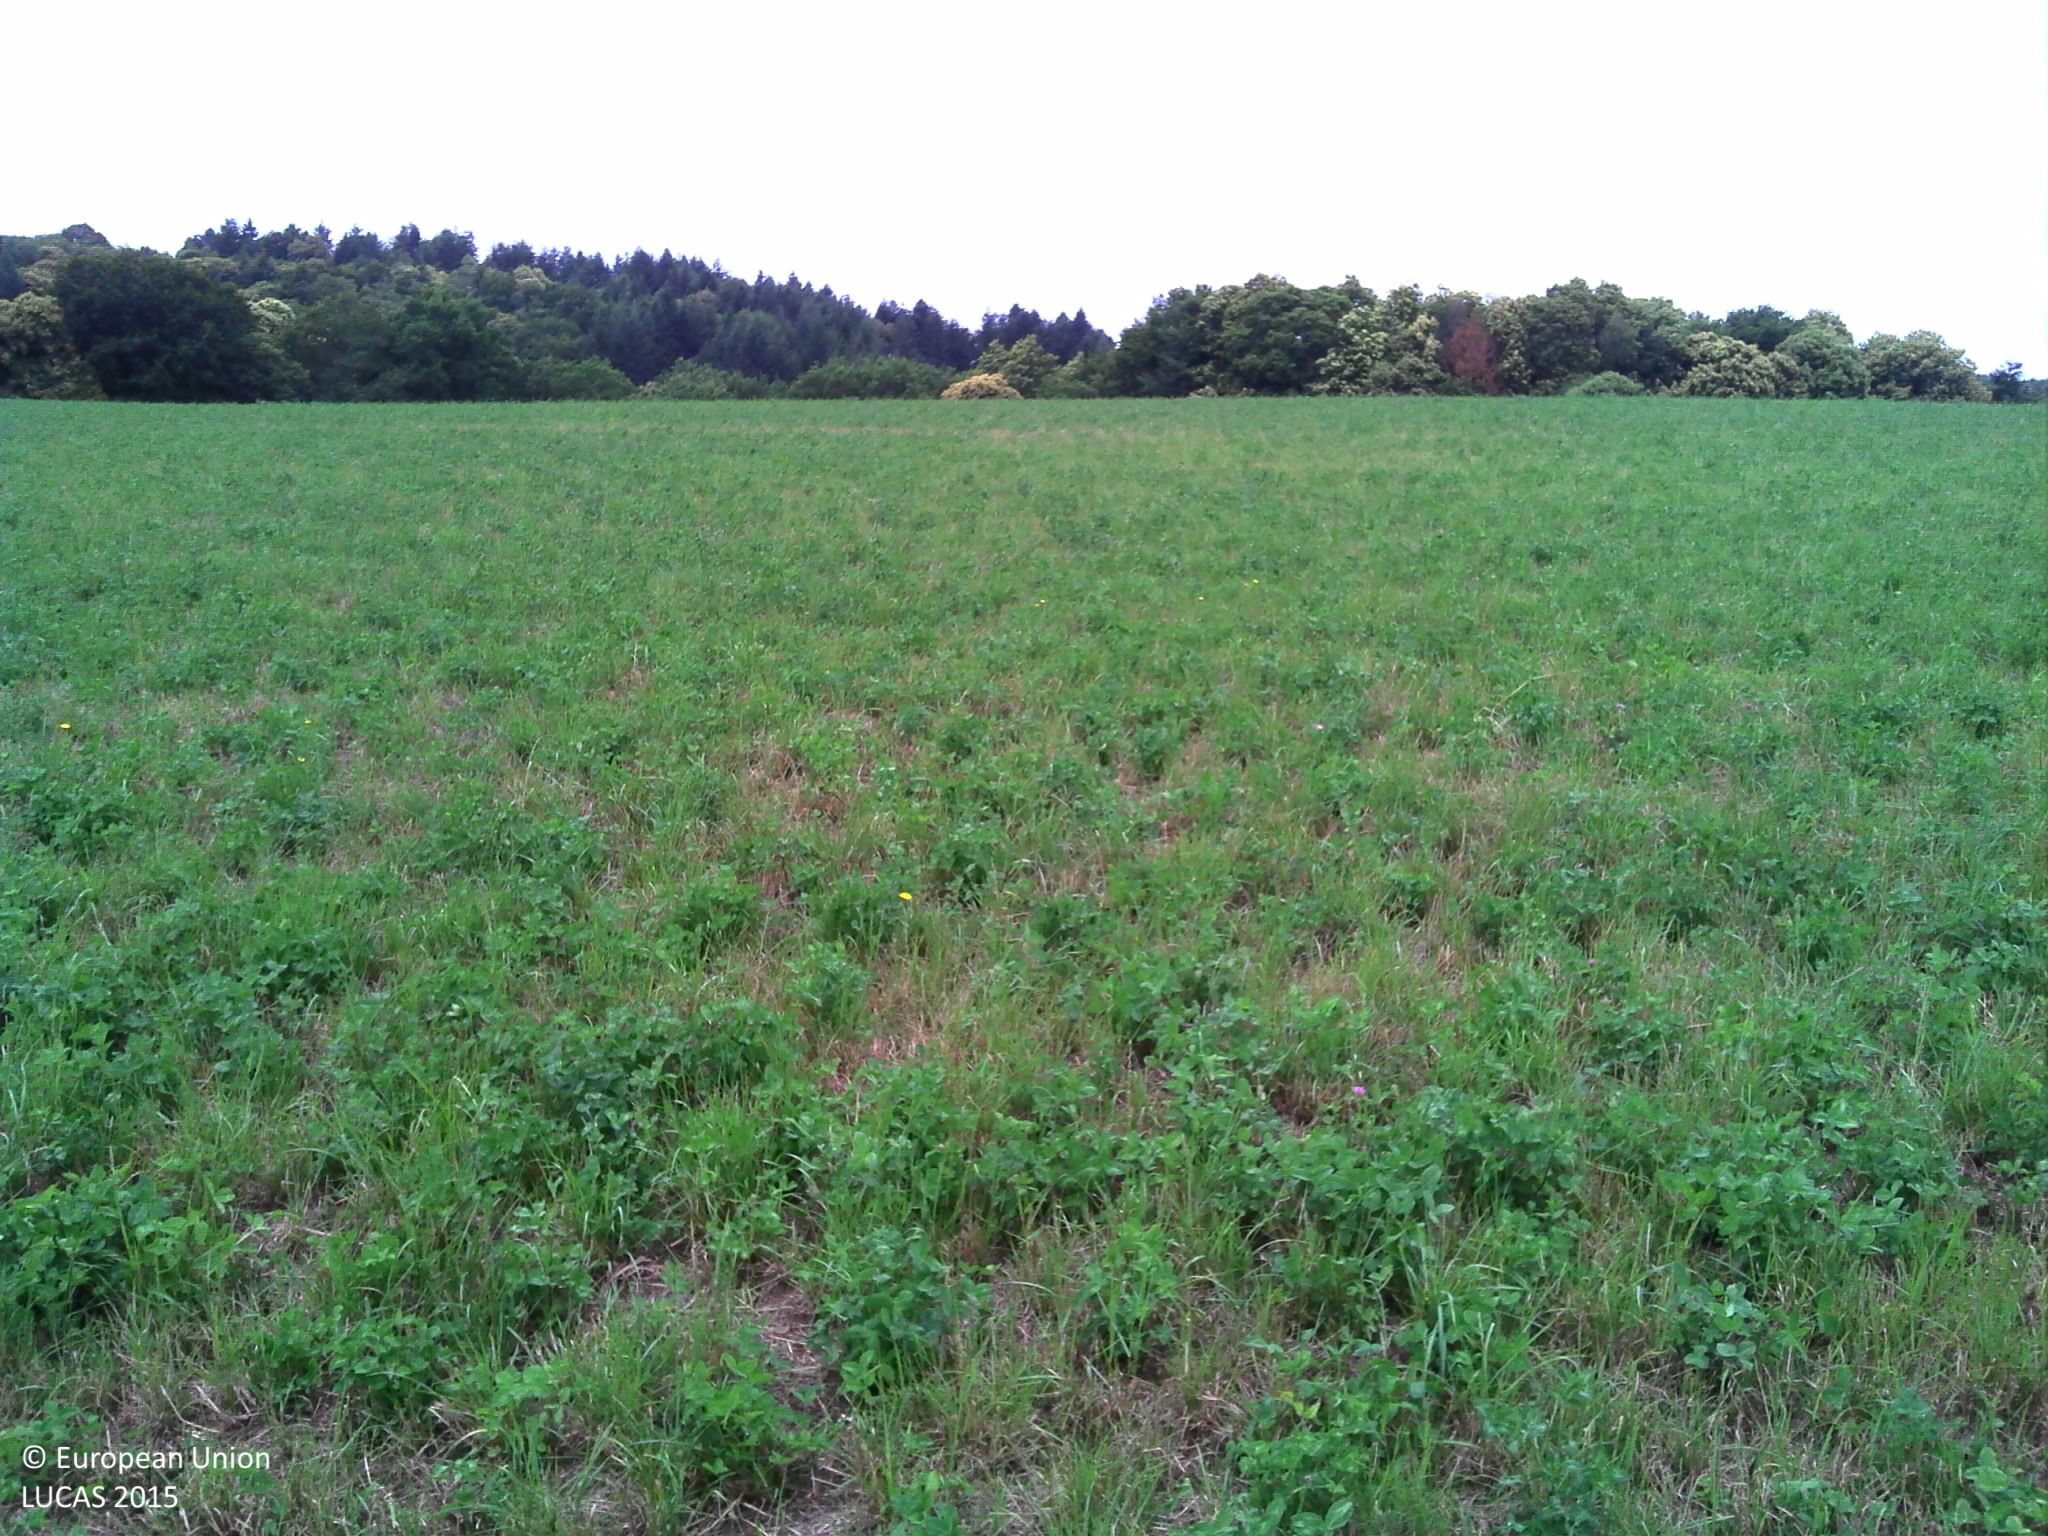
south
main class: Cropland
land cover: Temporary grasslands
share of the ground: > 75 %
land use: Agriculture (excluding fallow land and kitchen gardens)
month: July
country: FR
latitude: 47.8441
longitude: -3.2058
